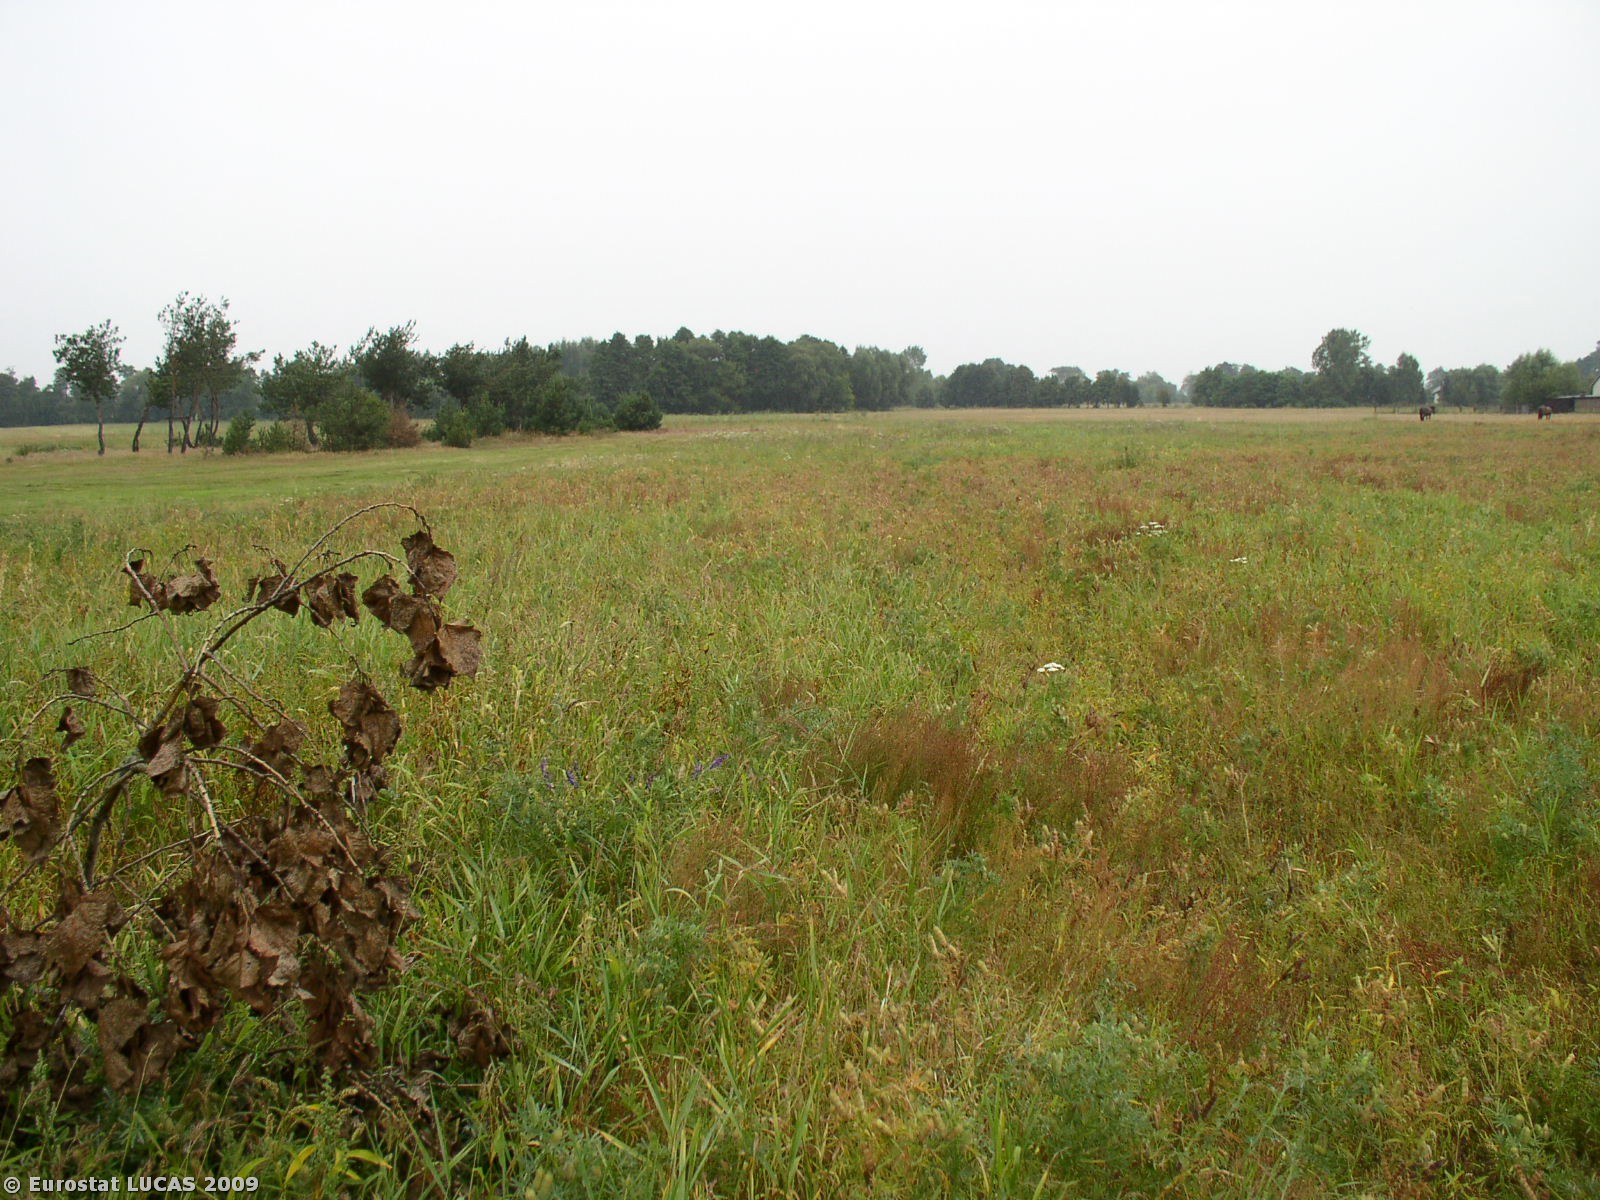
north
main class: Cropland
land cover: Dry pulses
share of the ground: 50 - 75 %
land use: Agriculture (excluding fallow land and kitchen gardens)
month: August
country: PL
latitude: 51.8642
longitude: 21.5679
